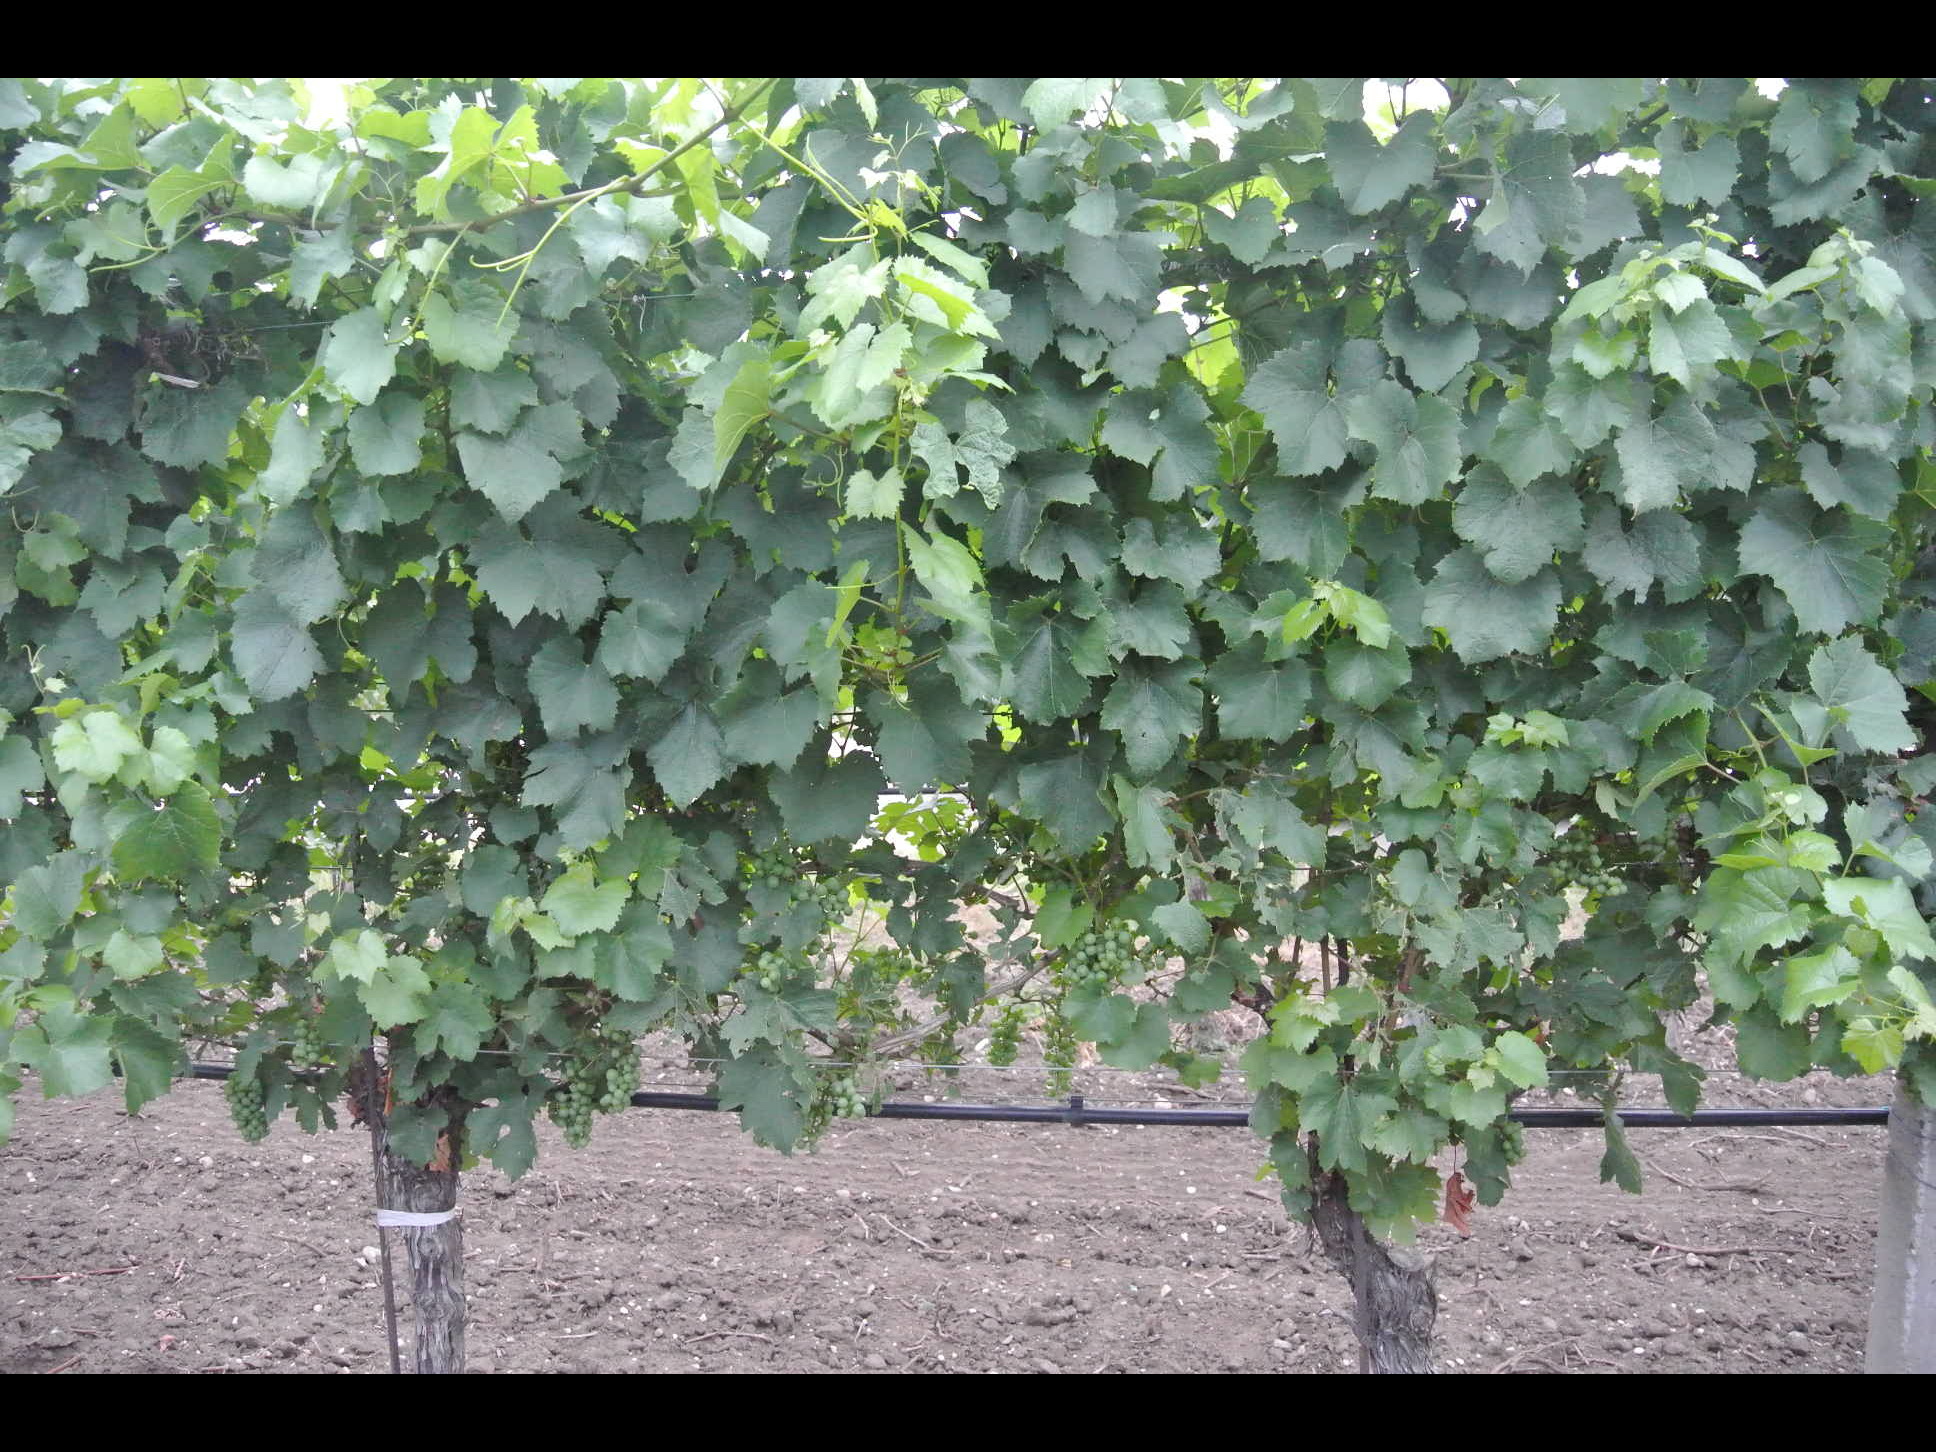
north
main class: Cropland
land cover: Vineyards
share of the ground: 25 - 50 %
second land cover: Other bare soil
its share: > 75 %
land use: Agriculture (excluding fallow land and kitchen gardens)
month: July
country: AT
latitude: 47.7967
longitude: 16.8011
